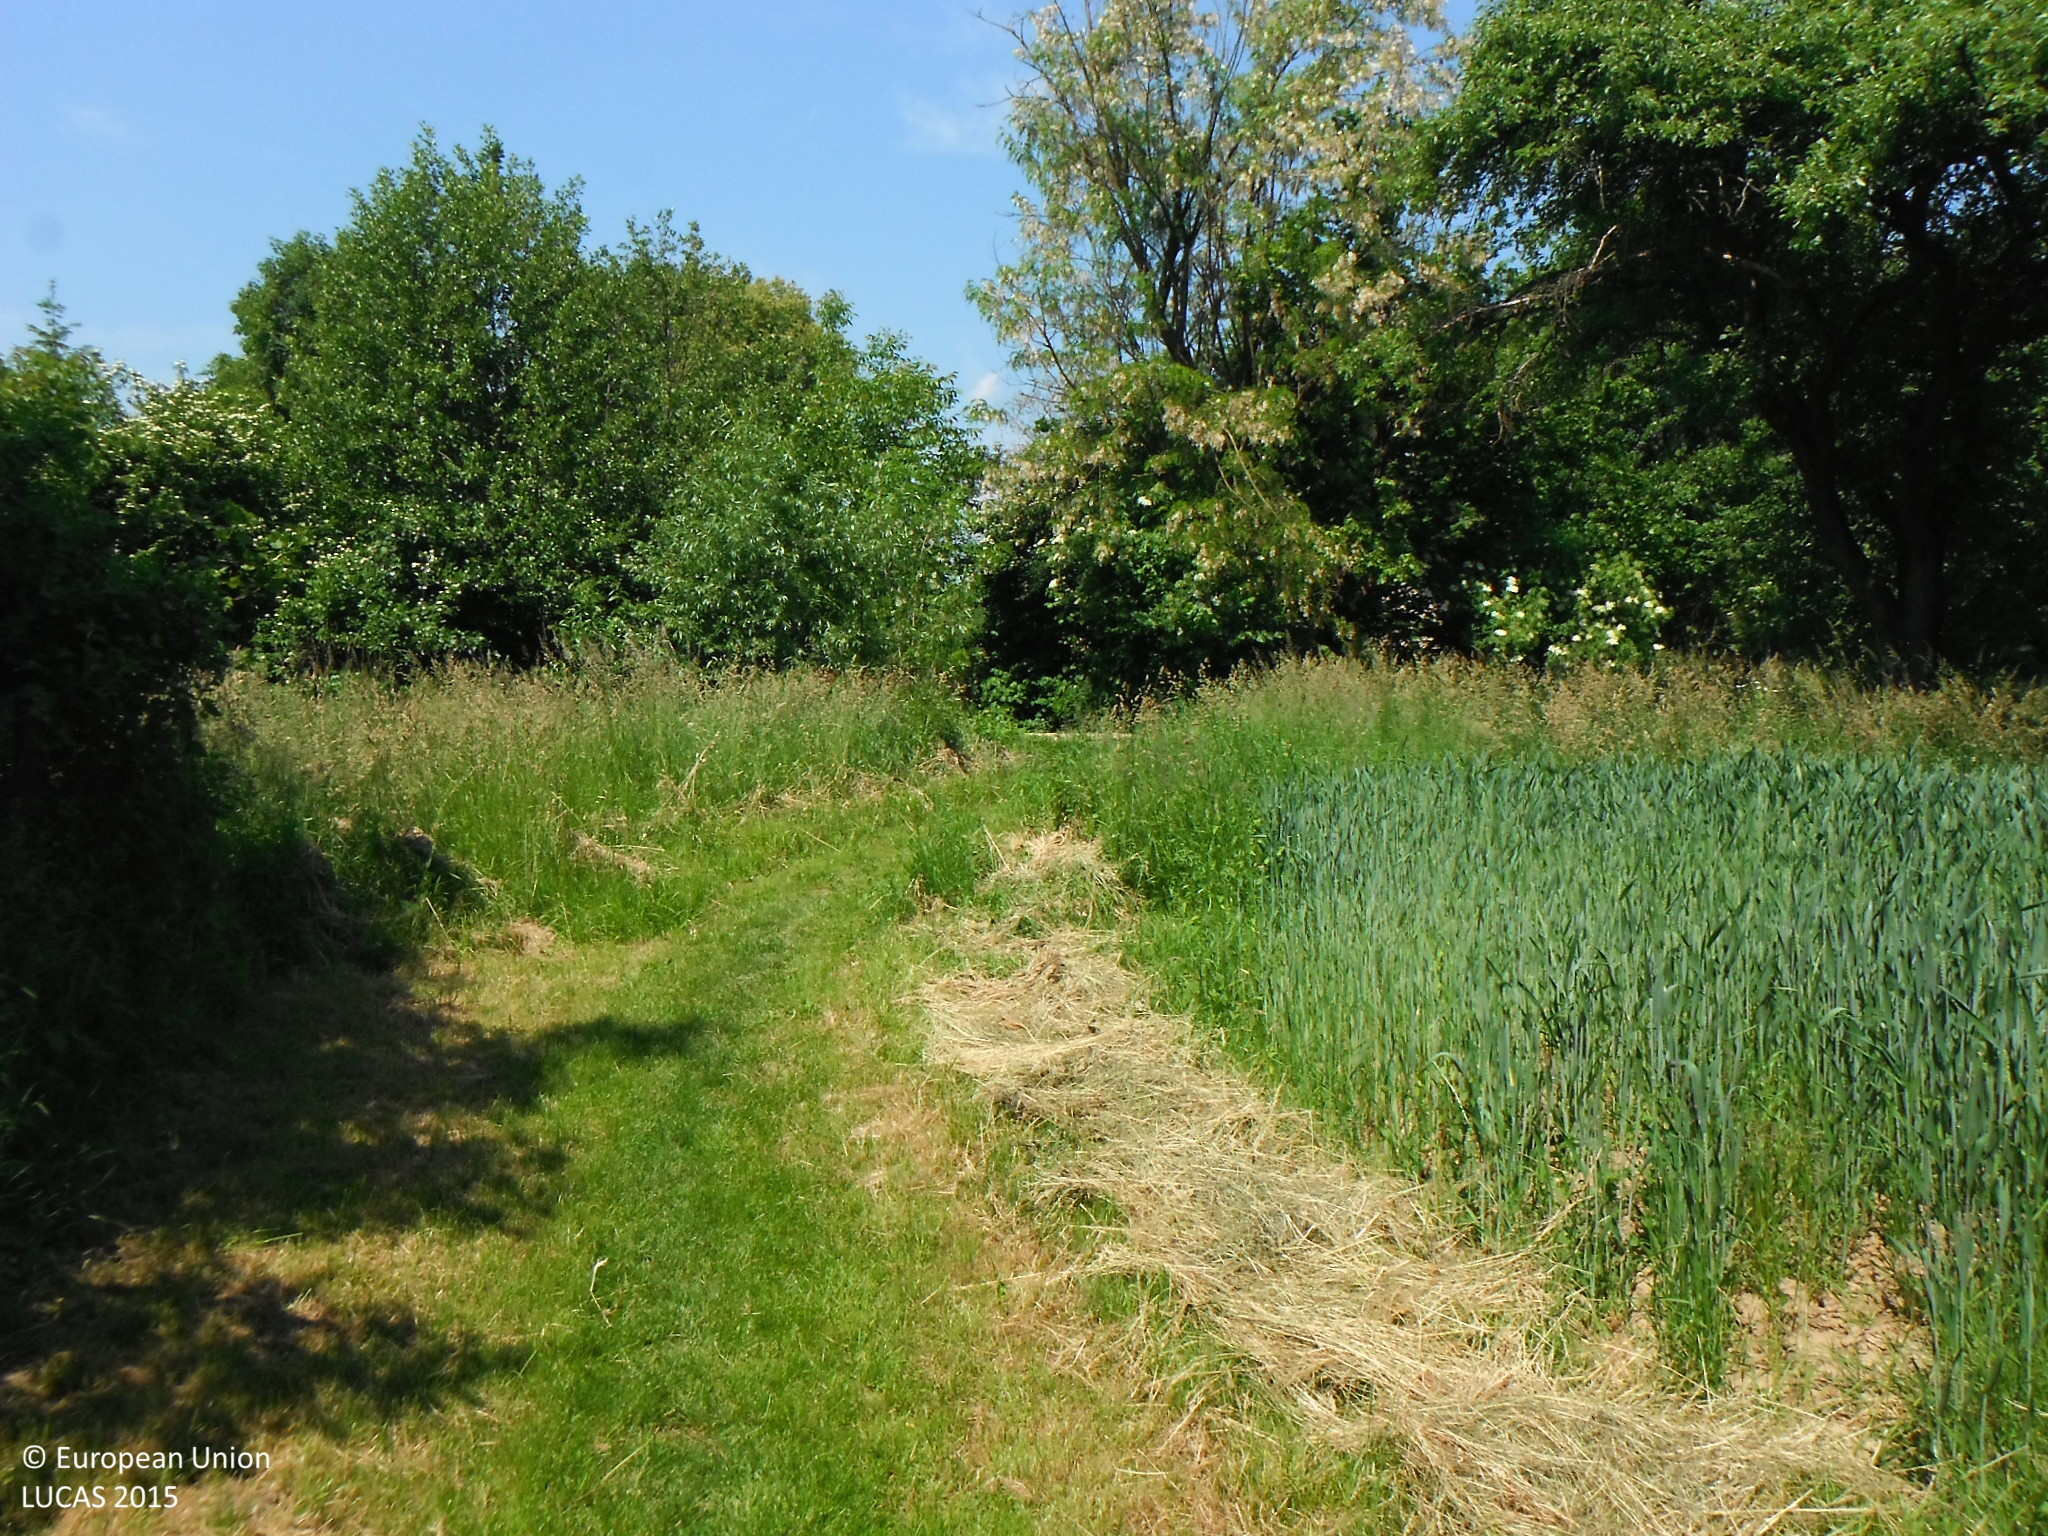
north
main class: Cropland
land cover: Nuts trees
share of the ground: > 75 %
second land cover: Grassland without tree/shrub cover
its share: > 75 %
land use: Kitchen garden
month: June
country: SK
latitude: 48.9932
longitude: 21.5707
